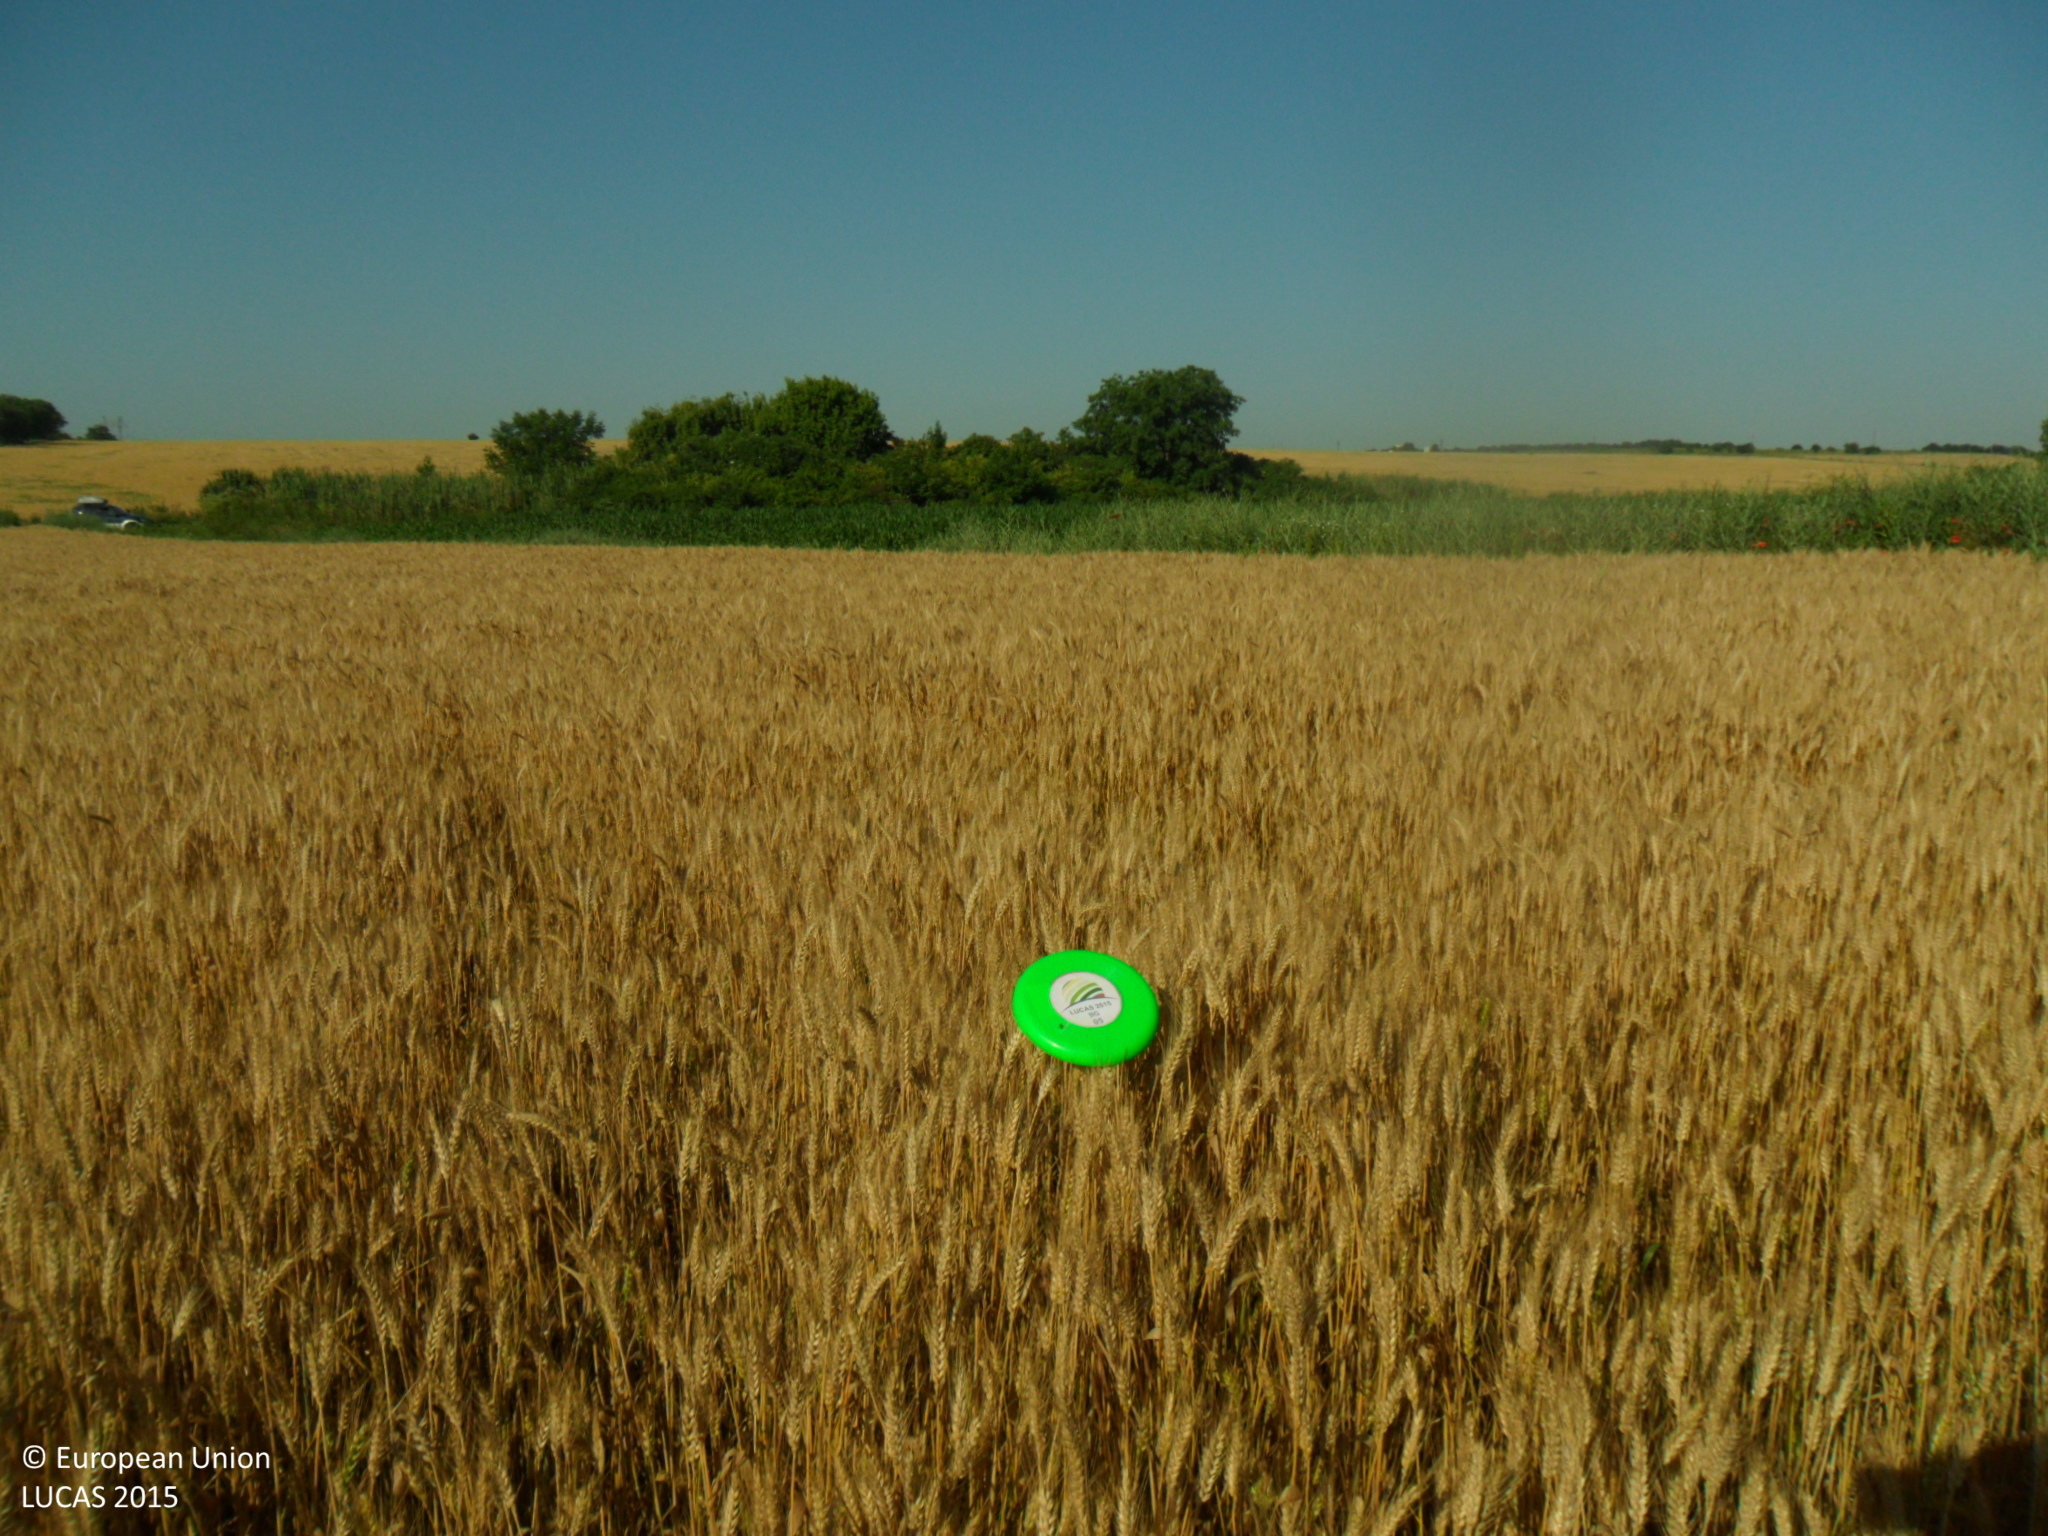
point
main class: Cropland
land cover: Common wheat
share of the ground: > 75 %
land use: Agriculture (excluding fallow land and kitchen gardens)
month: June
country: BG
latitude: 43.3275
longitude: 27.0743
